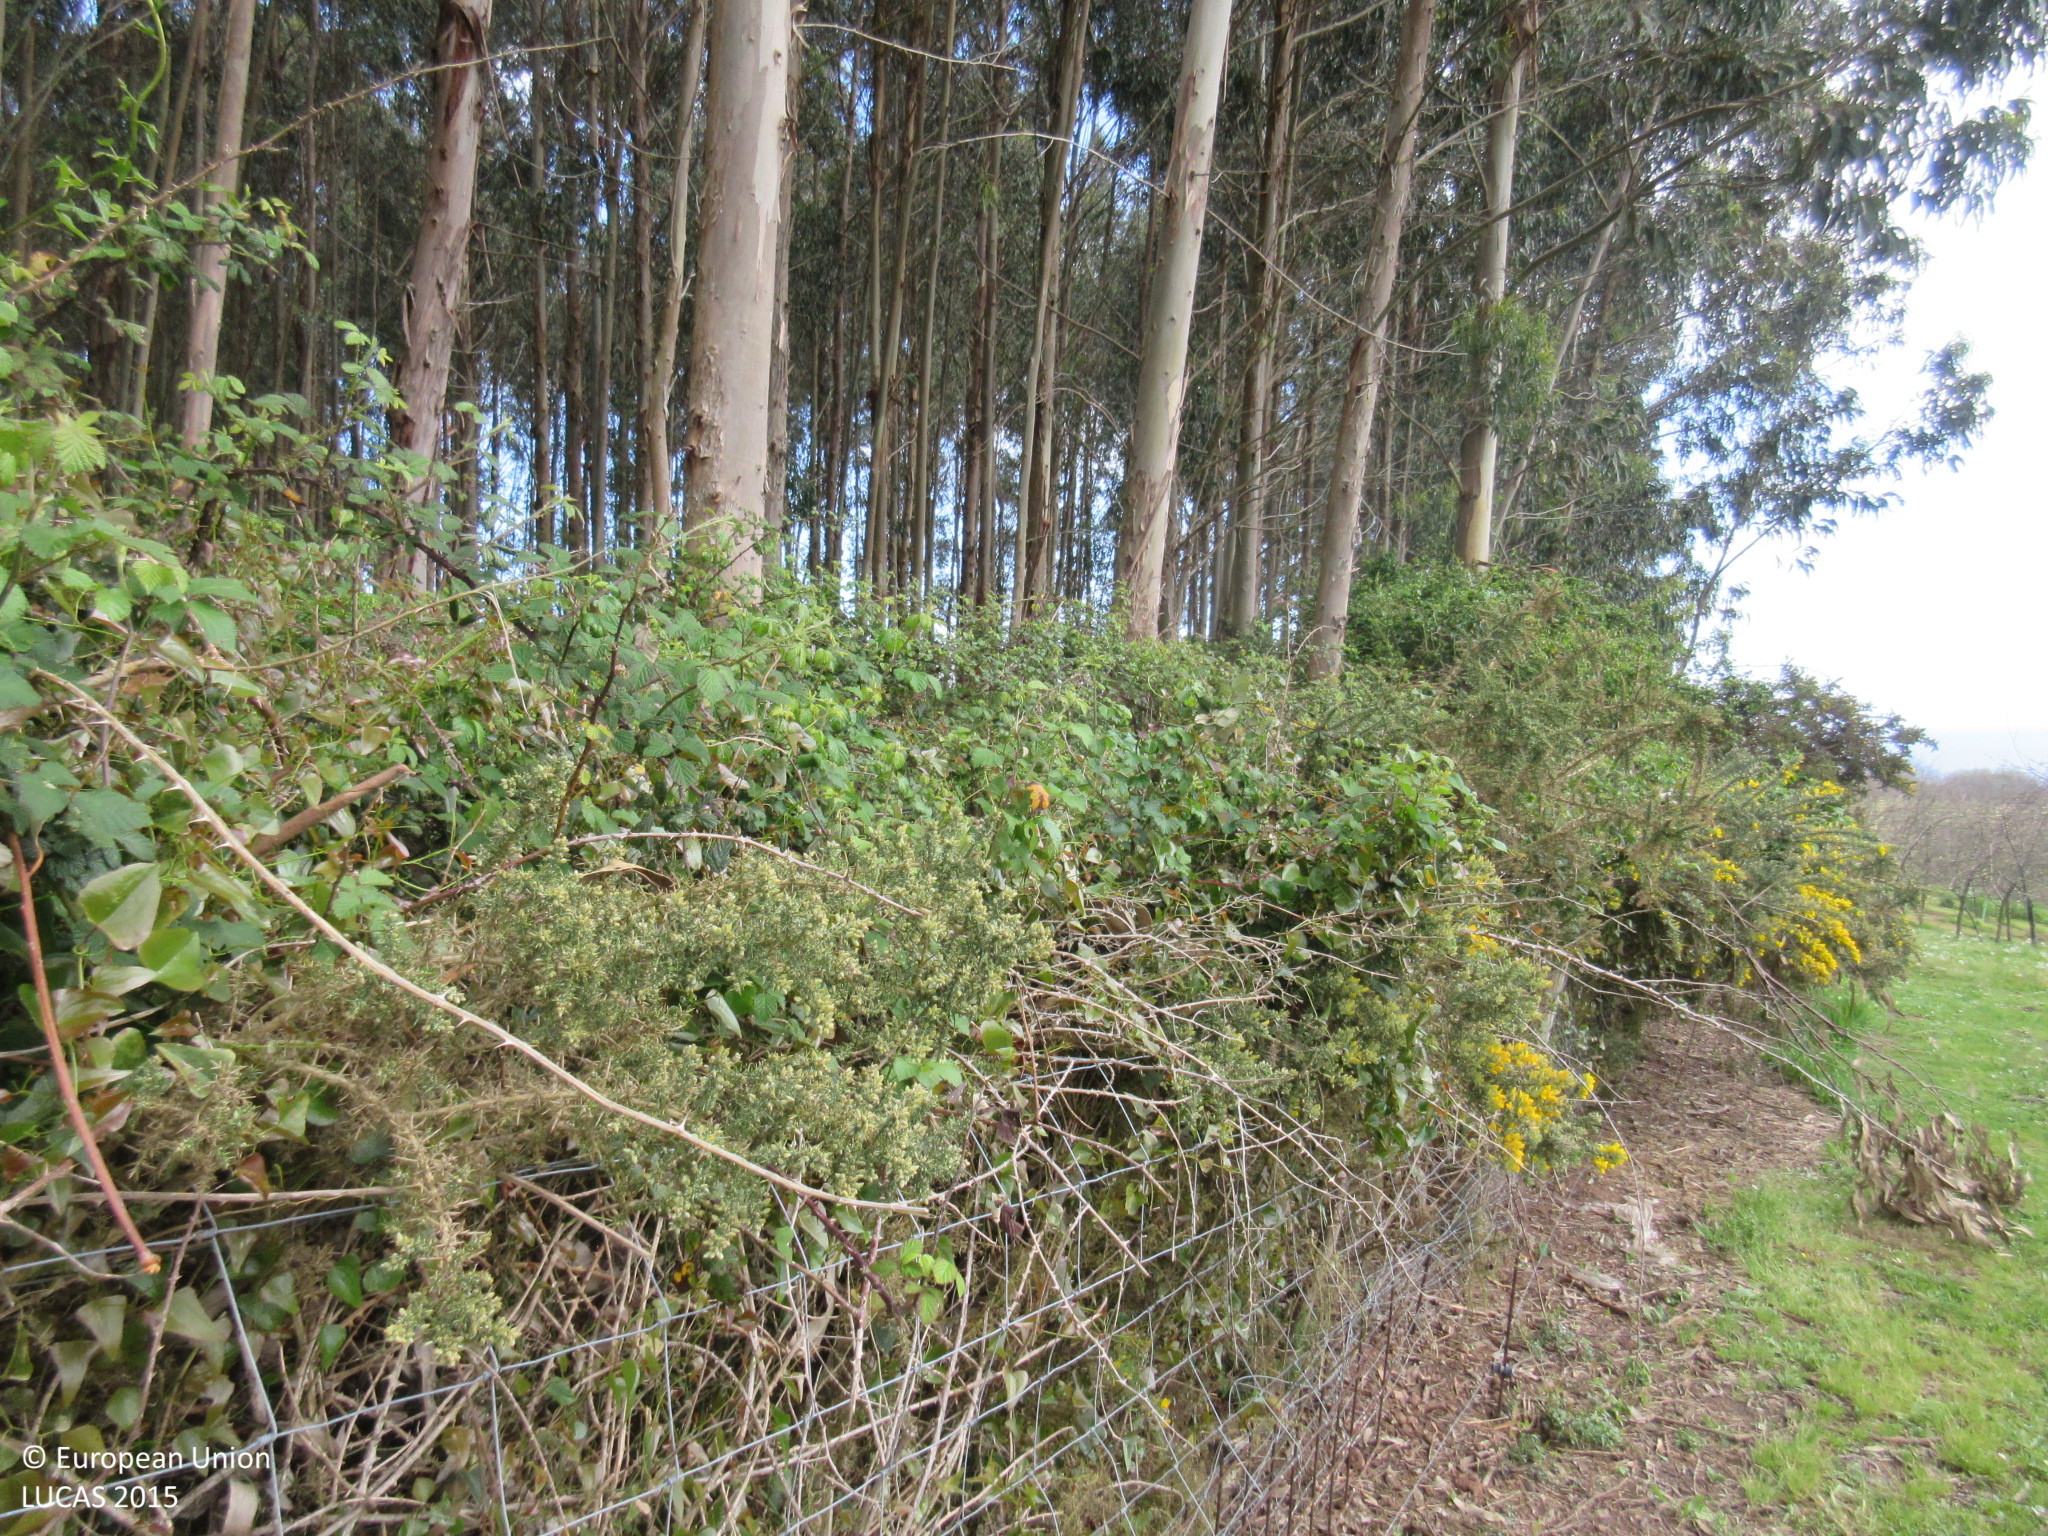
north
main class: Woodland
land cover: Broadleaved woodland
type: exotic forest
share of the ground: > 75 %
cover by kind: broadleaved forest trees 90 %, shrubs 10 %
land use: Forestry
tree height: > 5 m
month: April
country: ES
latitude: 43.4736
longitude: -5.1180
